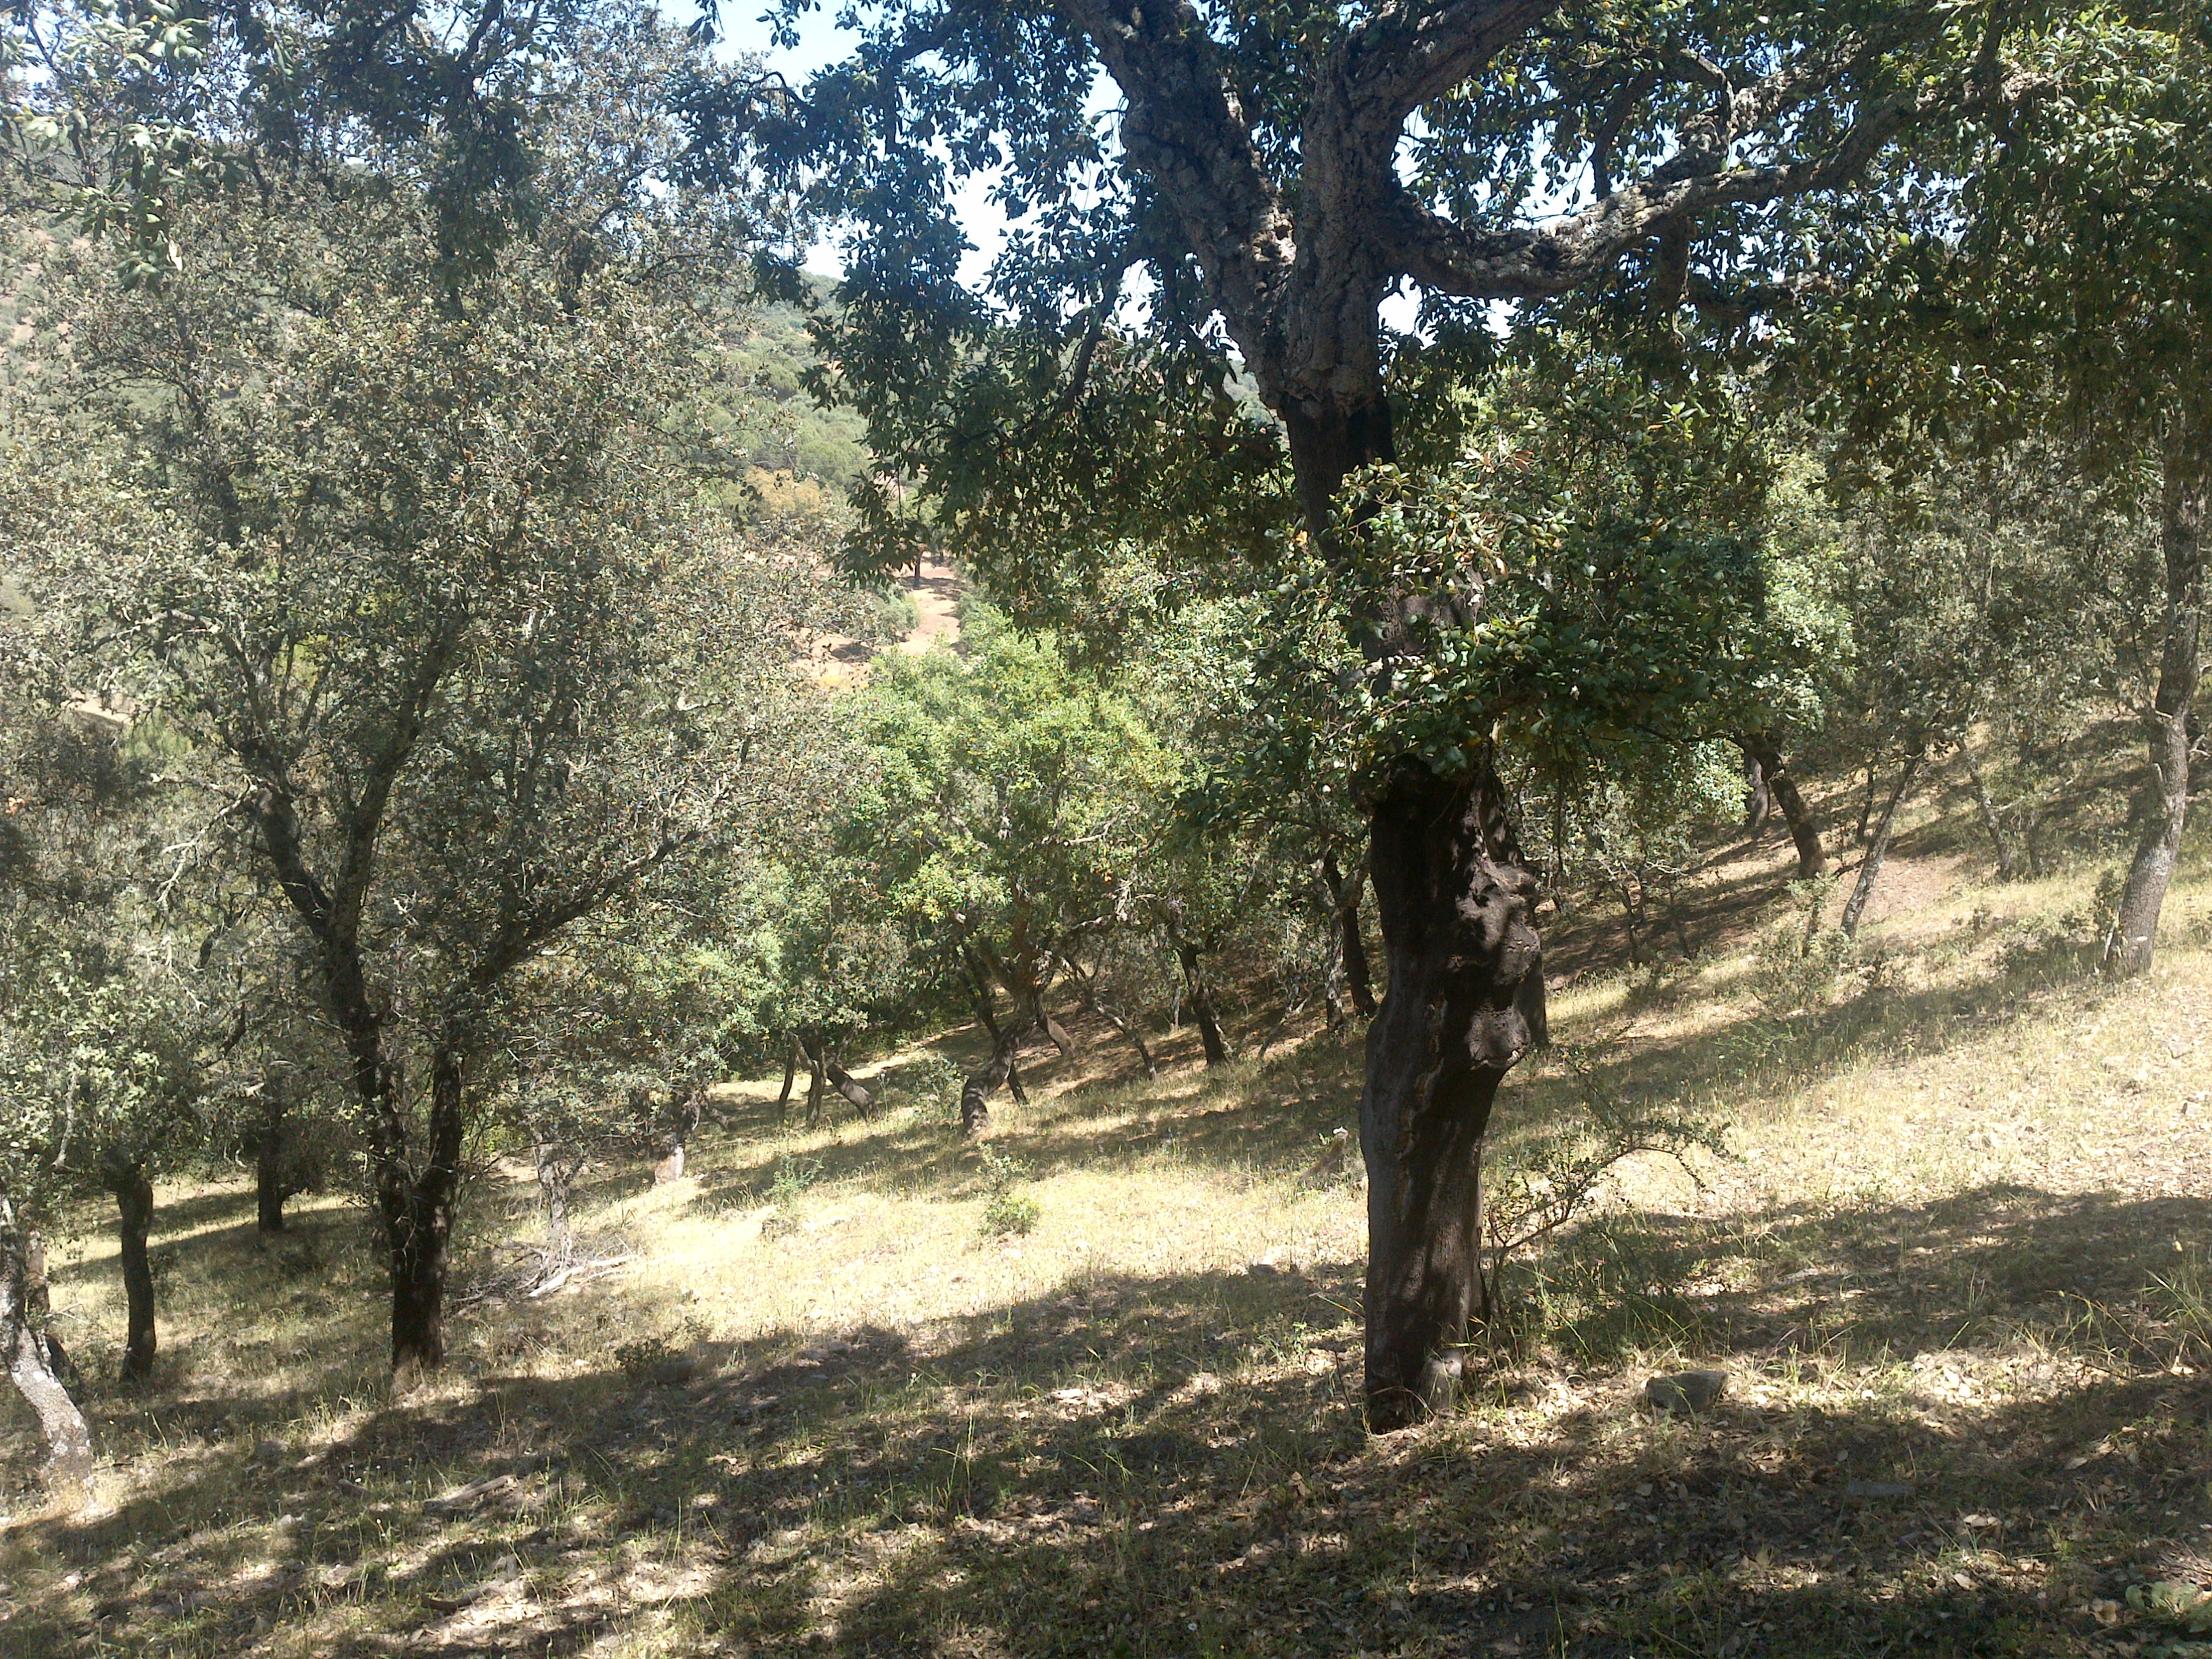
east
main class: Woodland
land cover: Broadleaved woodland
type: broadleaved evergreen forest
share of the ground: 50 - 75 %
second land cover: Spontaneously vegetated surfaces
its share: 10 - 25 %
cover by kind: broadleaved forest trees 60 %, shrubs 10 %, herbaceous plants 10 %, lichens and mosses 10 %, unconsolidated bare surface 10 %
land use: Forestry
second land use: Agriculture (excluding fallow land and kitchen gardens)
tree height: > 5 m
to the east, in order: Broadleaved woodland; Spontaneously vegetated surfaces; Fences; Inland fresh water bodies; Spontaneously vegetated surfaces; Fences; Spontaneously vegetated surfaces
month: May
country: ES
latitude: 37.9195
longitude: -4.9534
